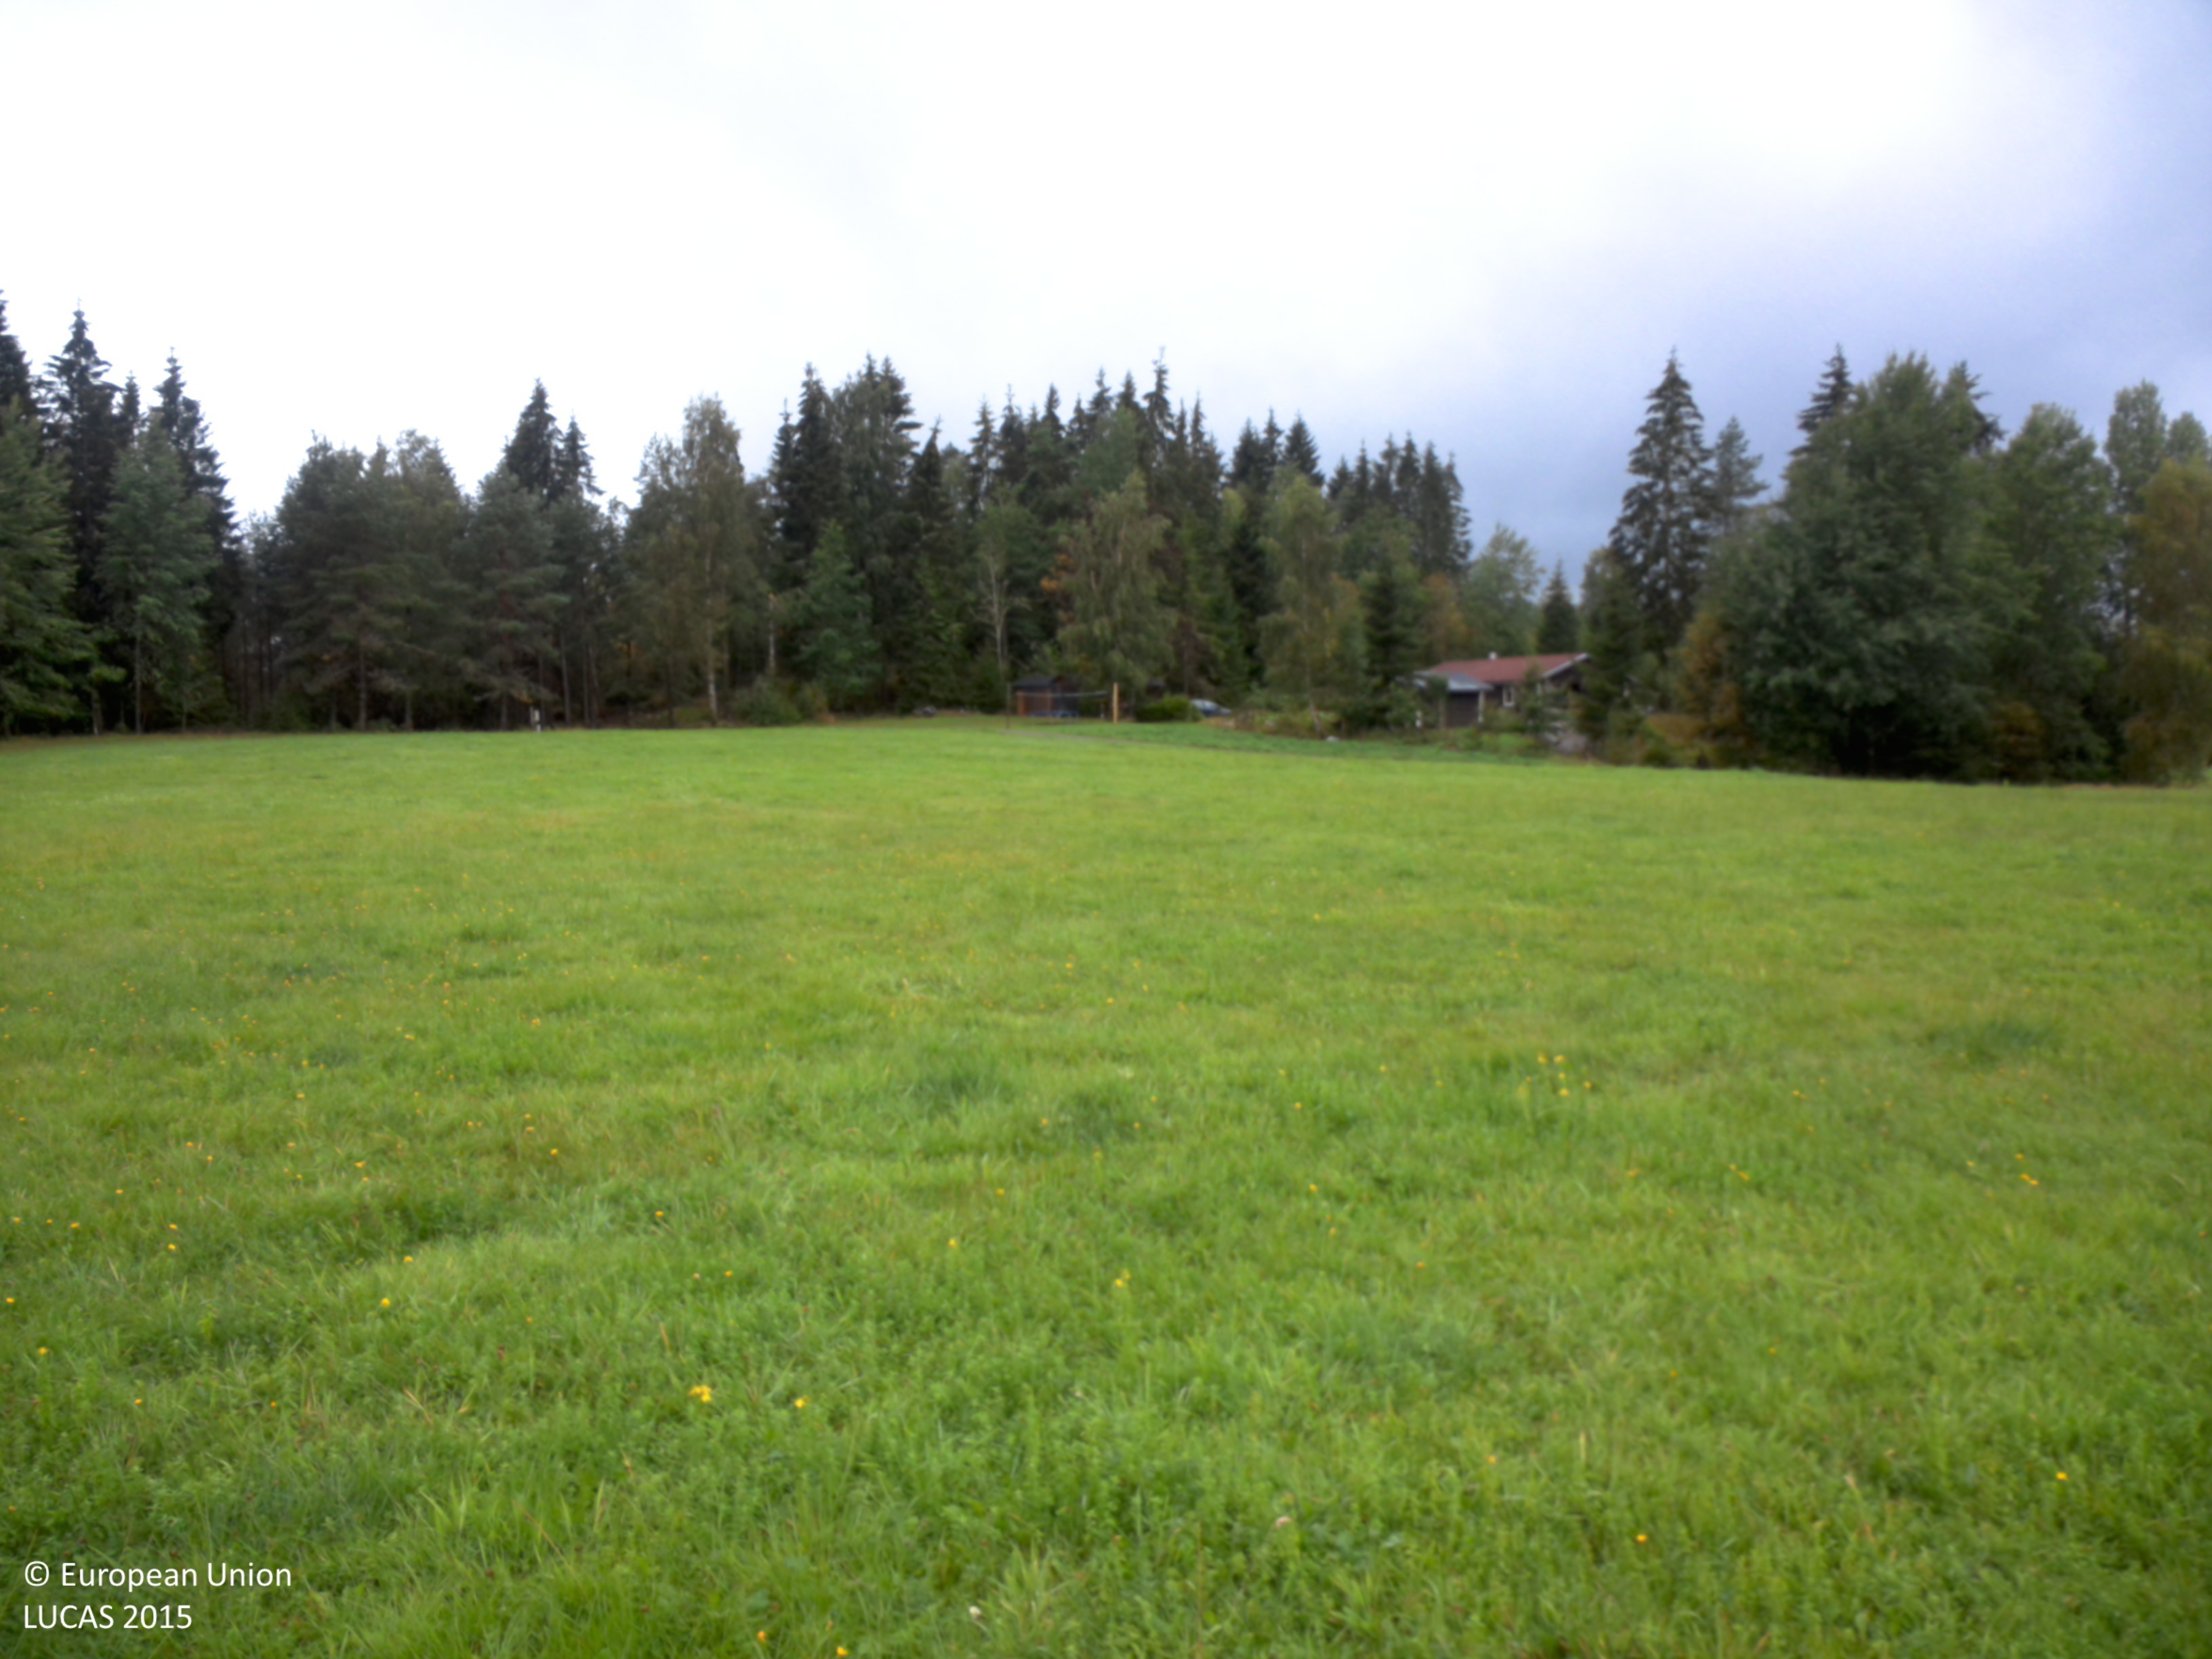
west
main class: Grassland
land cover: Grassland without tree/shrub cover
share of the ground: > 75 %
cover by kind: herbaceous plants 100 %
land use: Agriculture (excluding fallow land and kitchen gardens)
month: August
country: SE
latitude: 58.1095
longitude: 12.3208
